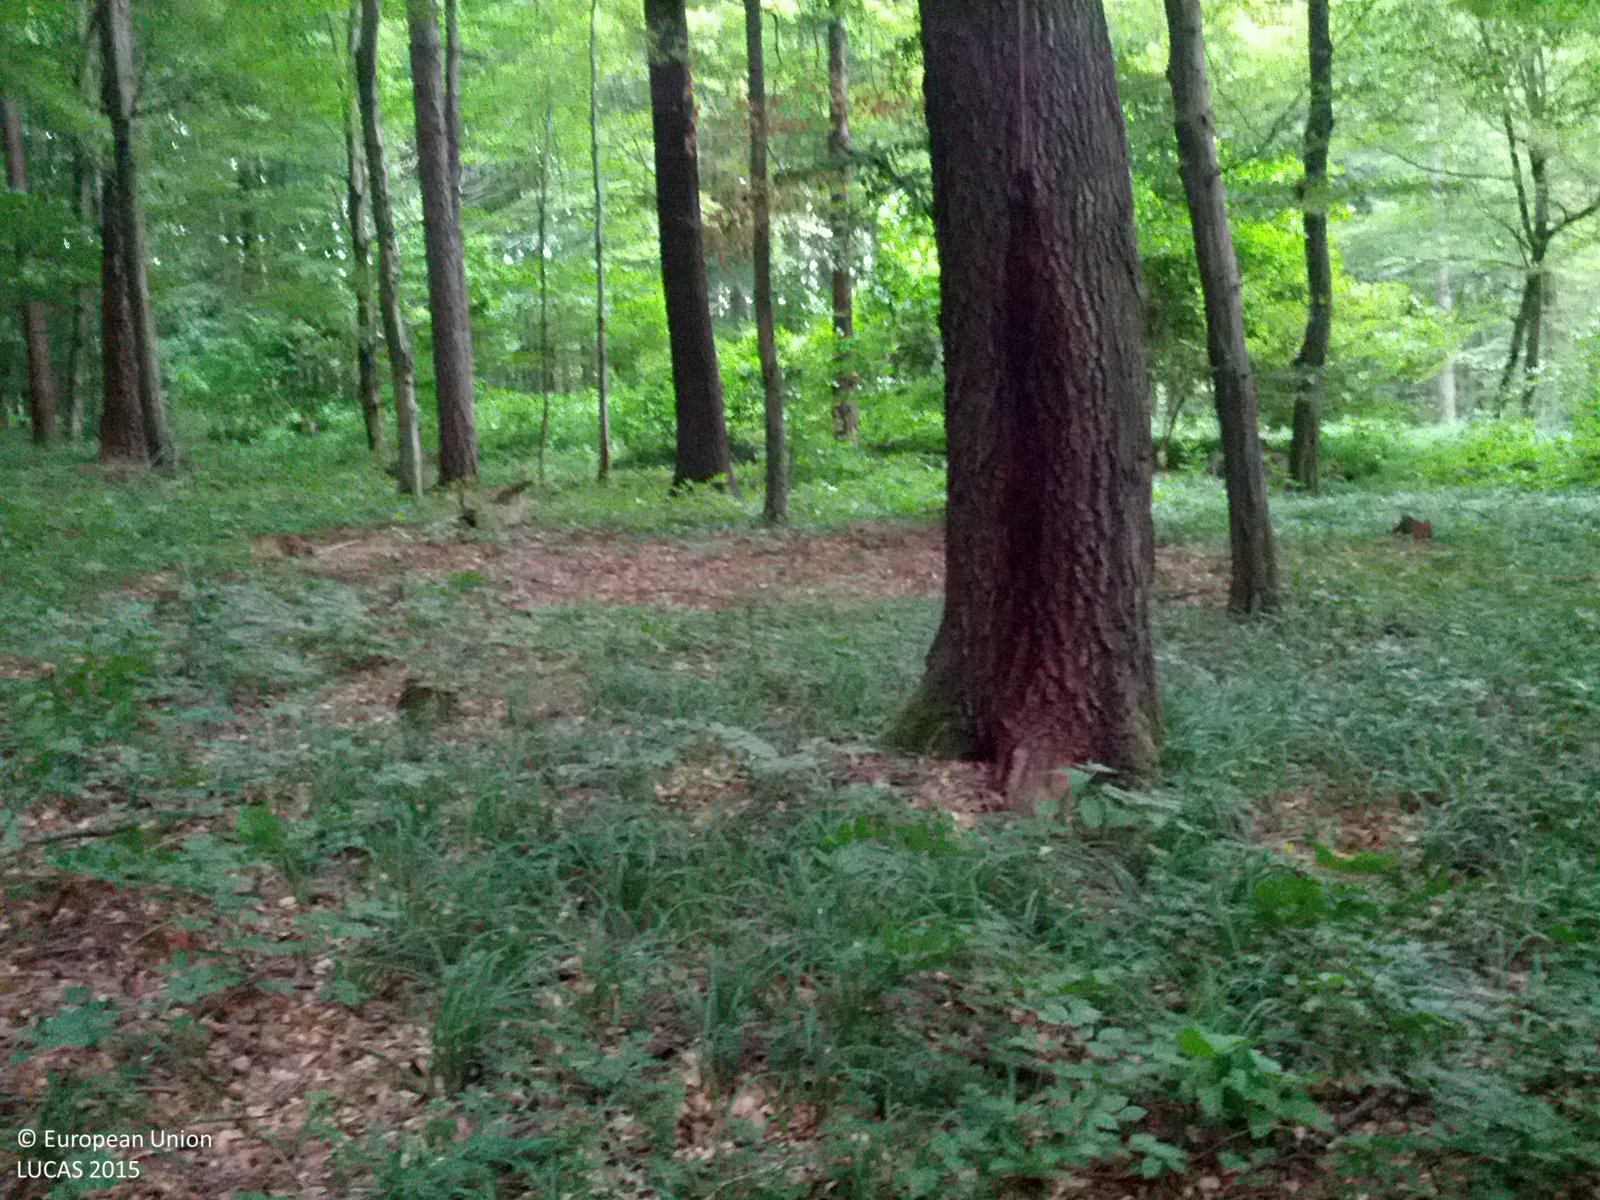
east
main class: Woodland
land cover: Other mixed woodland
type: alpine coniferous forest
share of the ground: > 75 %
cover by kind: coniferous forest trees 40 %, broadleaved forest trees 40 %, herbaceous plants 15 %, shrubs 5 %
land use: Forestry
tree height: > 5 m
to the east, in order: Other mixed woodland; Tracks; Other mixed woodland; Broadleaved woodland
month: June
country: AT
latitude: 48.1976
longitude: 16.1257
